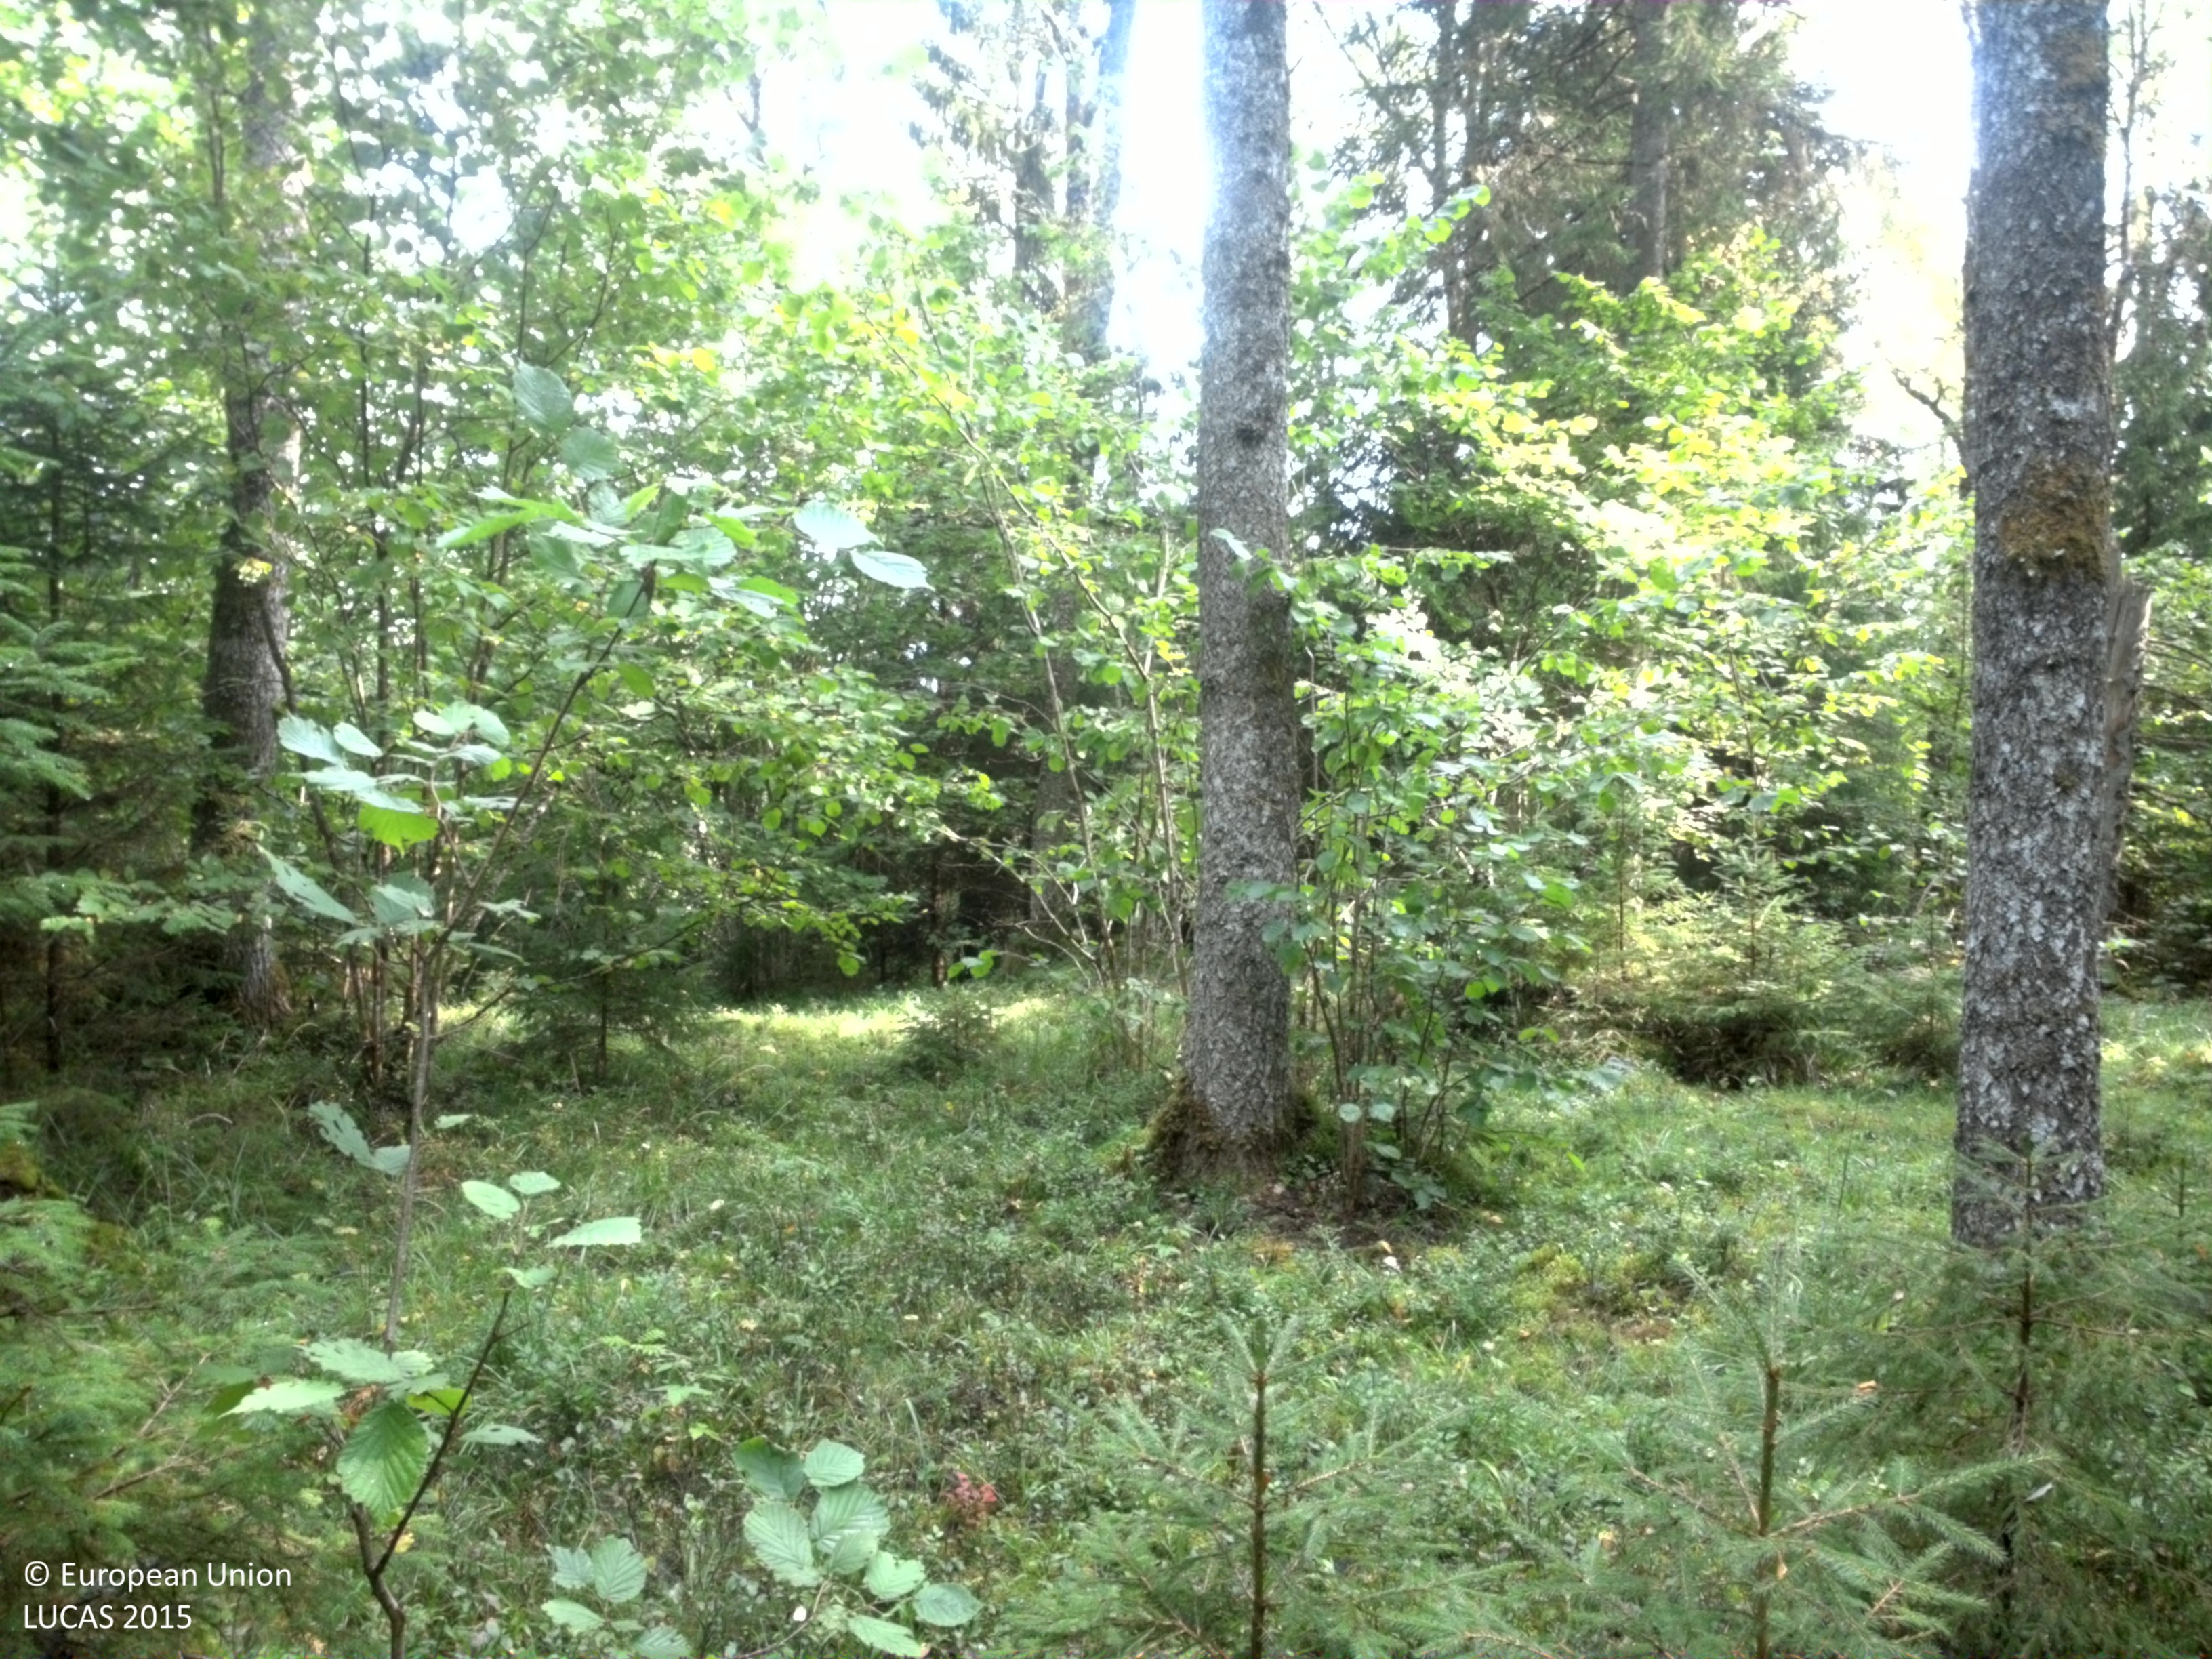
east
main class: Woodland
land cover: Spruce dominated mixed woodland
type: boreal forest
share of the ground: 25 - 50 %
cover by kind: coniferous forest trees 25 %, broadleaved forest trees 25 %, herbaceous plants 20 %, lichens and mosses 20 %, shrubs 10 %
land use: Agriculture (excluding fallow land and kitchen gardens)
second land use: Forestry
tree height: > 5 m
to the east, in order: Spruce dominated mixed woodland; Broadleaved woodland; Spruce dominated mixed woodland; Broadleaved woodland; Tracks; Broadleaved woodland; Fences; Spruce dominated coniferous woodland
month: August
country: SE
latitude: 57.9450
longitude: 13.9646
